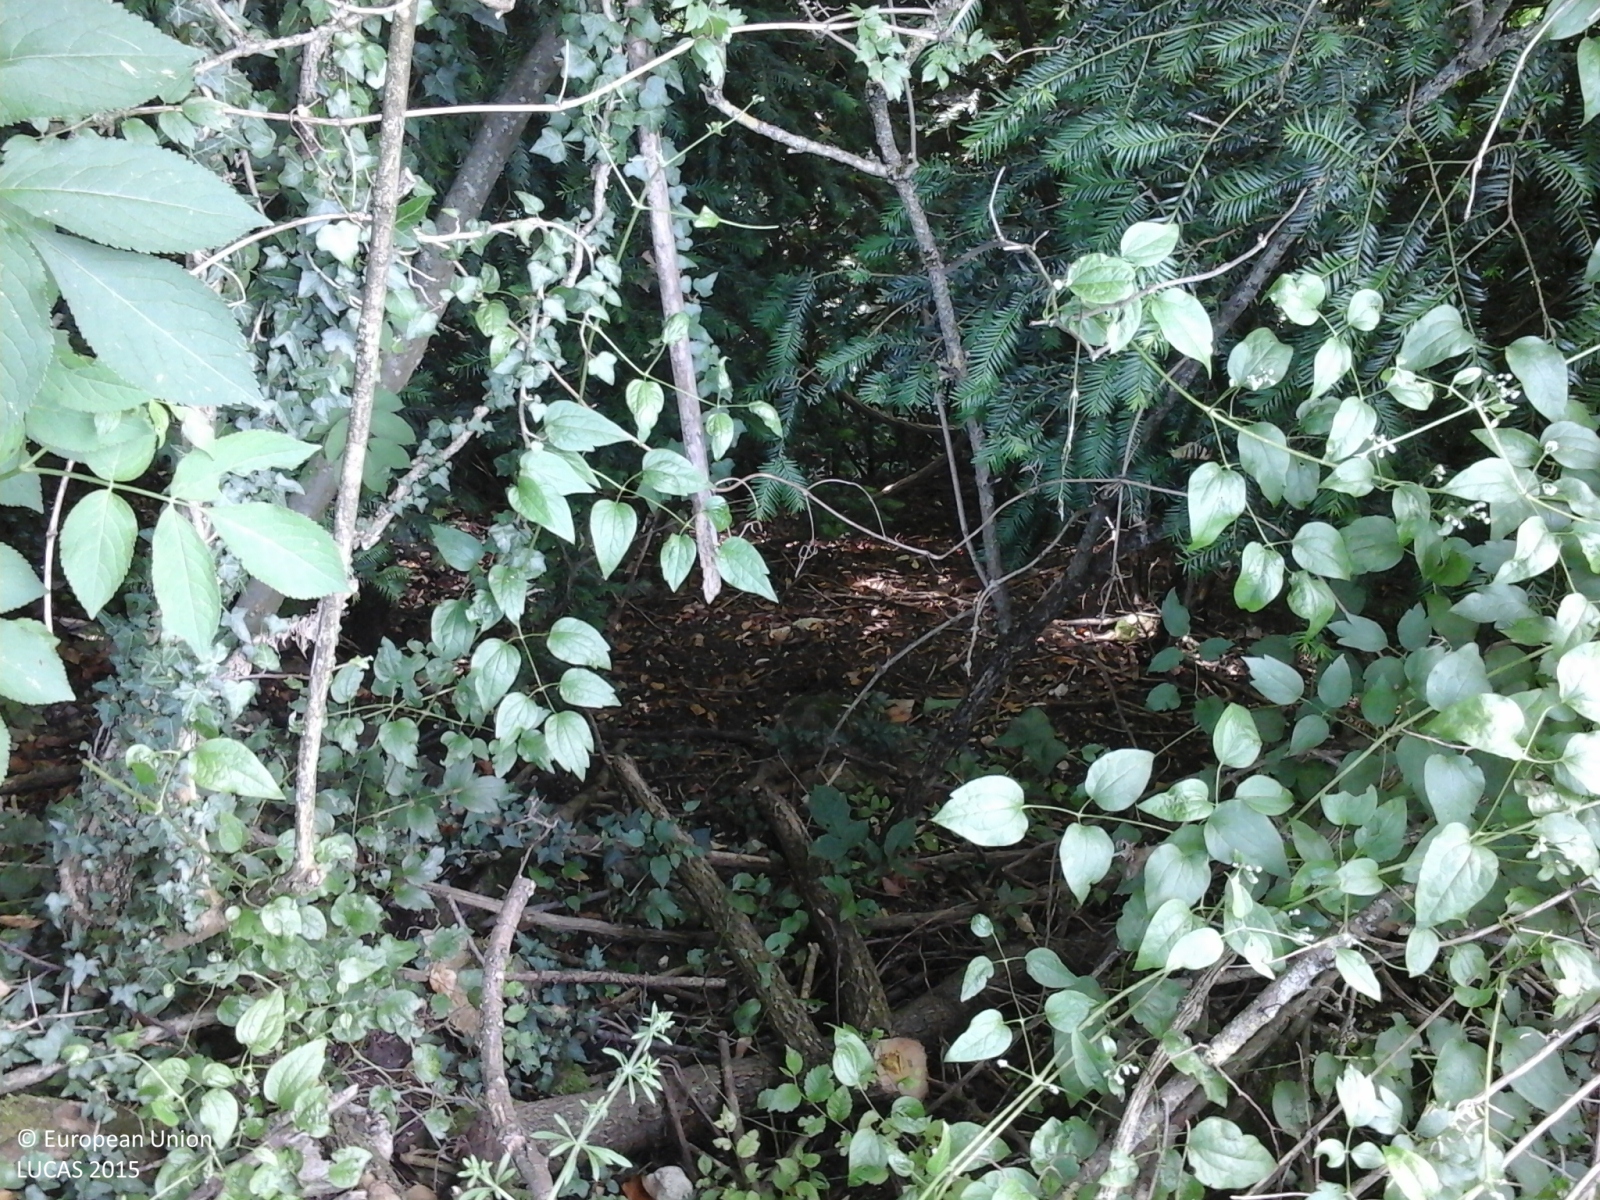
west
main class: Woodland
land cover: Broadleaved woodland
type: thermophilous deciduous forest
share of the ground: > 75 %
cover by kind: broadleaved forest trees 100 %
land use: Semi-natural and natural areas not in use
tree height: > 5 m
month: June
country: IT
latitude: 46.1296
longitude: 12.2363
